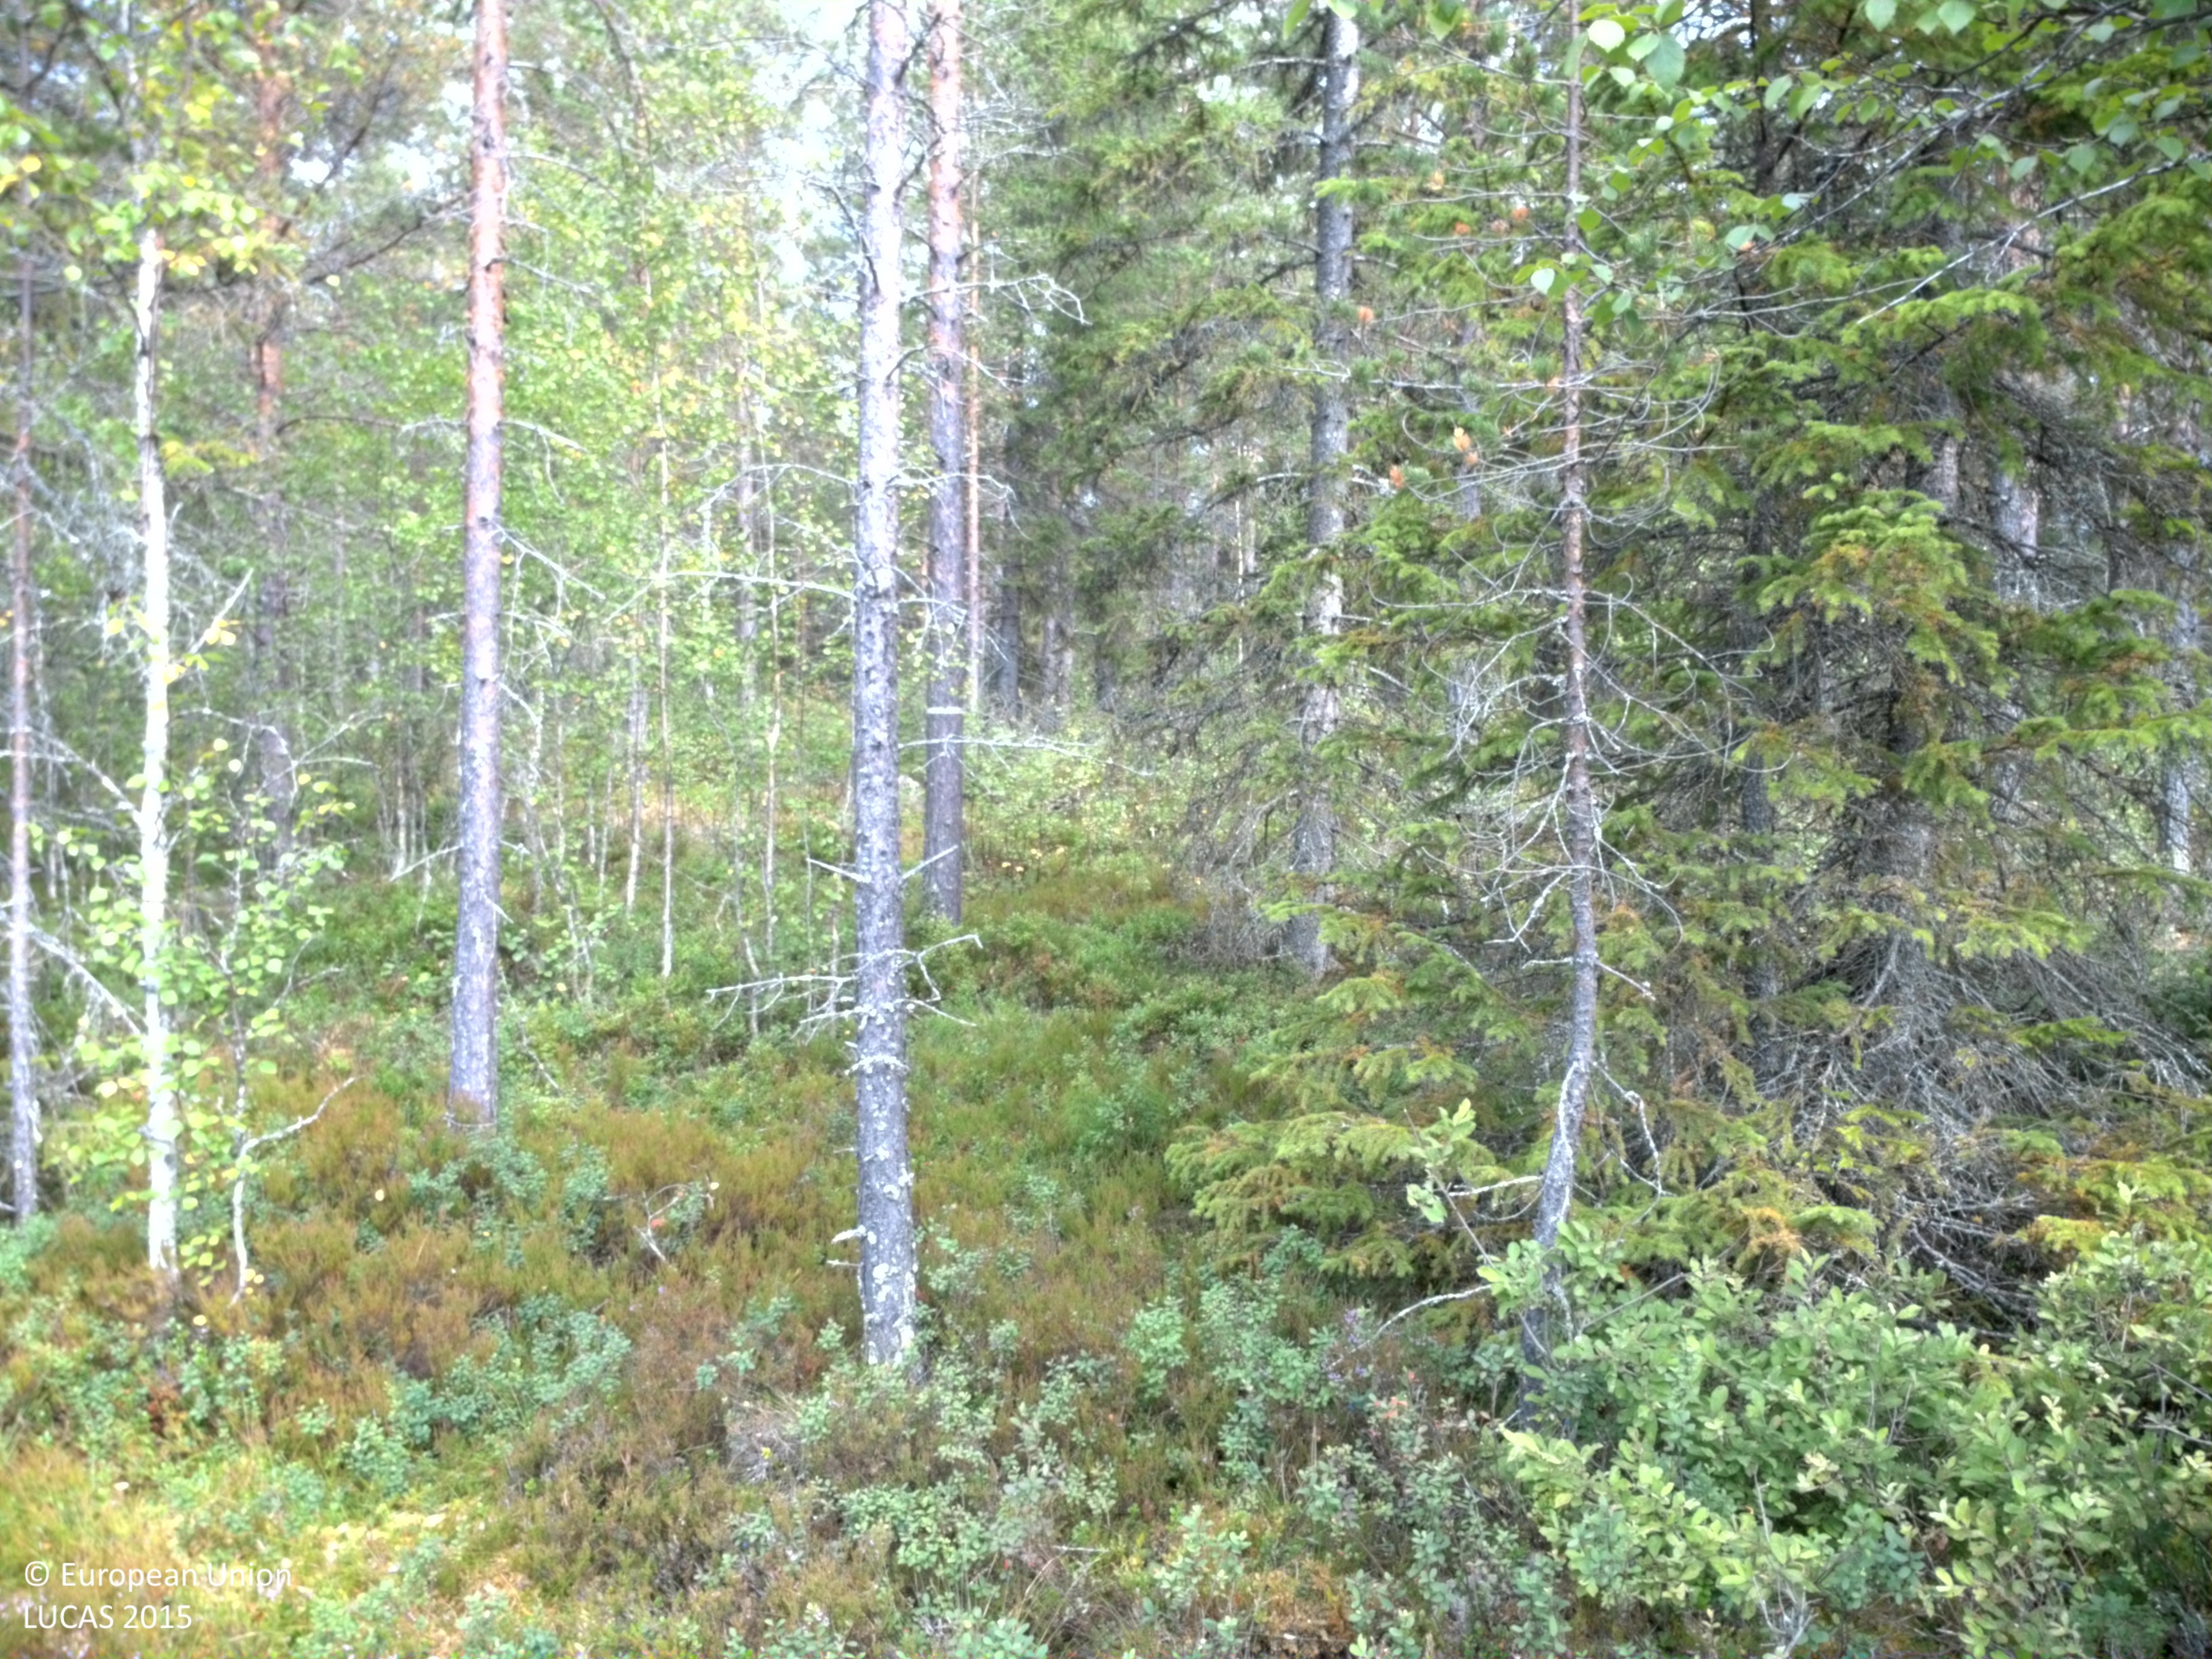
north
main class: Woodland
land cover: Pine dominated mixed woodland
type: boreal forest
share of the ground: 25 - 50 %
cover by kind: coniferous forest trees 35 %, lichens and mosses 25 %, shrubs 20 %, broadleaved forest trees 15 %, herbaceous plants 5 %
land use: Forestry
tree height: > 5 m
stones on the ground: < 10 %
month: August
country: SE
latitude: 61.8628
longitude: 14.9443
